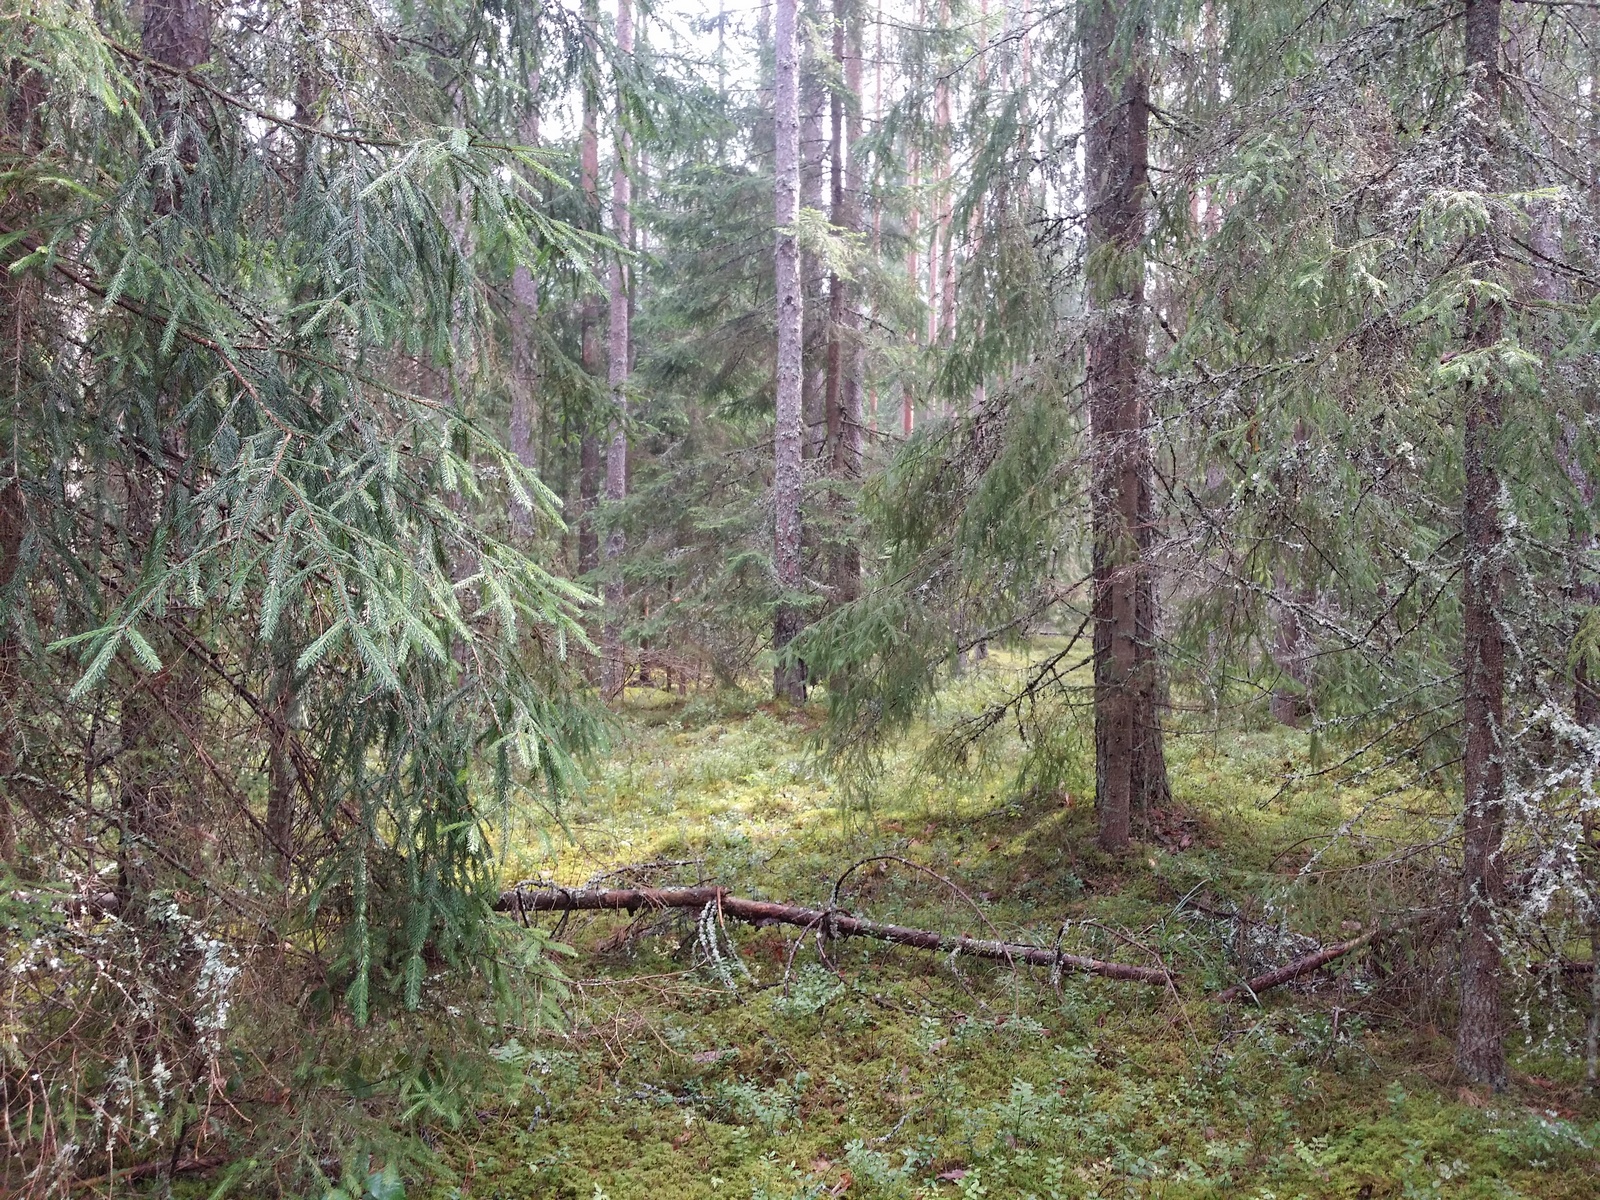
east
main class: Woodland
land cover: Other coniferous woodland
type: hemiboreal forest and nemoral coniferous forest and mixed broadleaved-coniferous forest
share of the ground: > 75 %
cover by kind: coniferous forest trees 80 %, lichens and mosses 15 %, herbaceous plants 5 %
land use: Forestry
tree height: > 5 m
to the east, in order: Other coniferous woodland; Tracks; Other coniferous woodland; Spruce dominated coniferous woodland
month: August
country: LV
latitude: 57.4968
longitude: 26.6836
